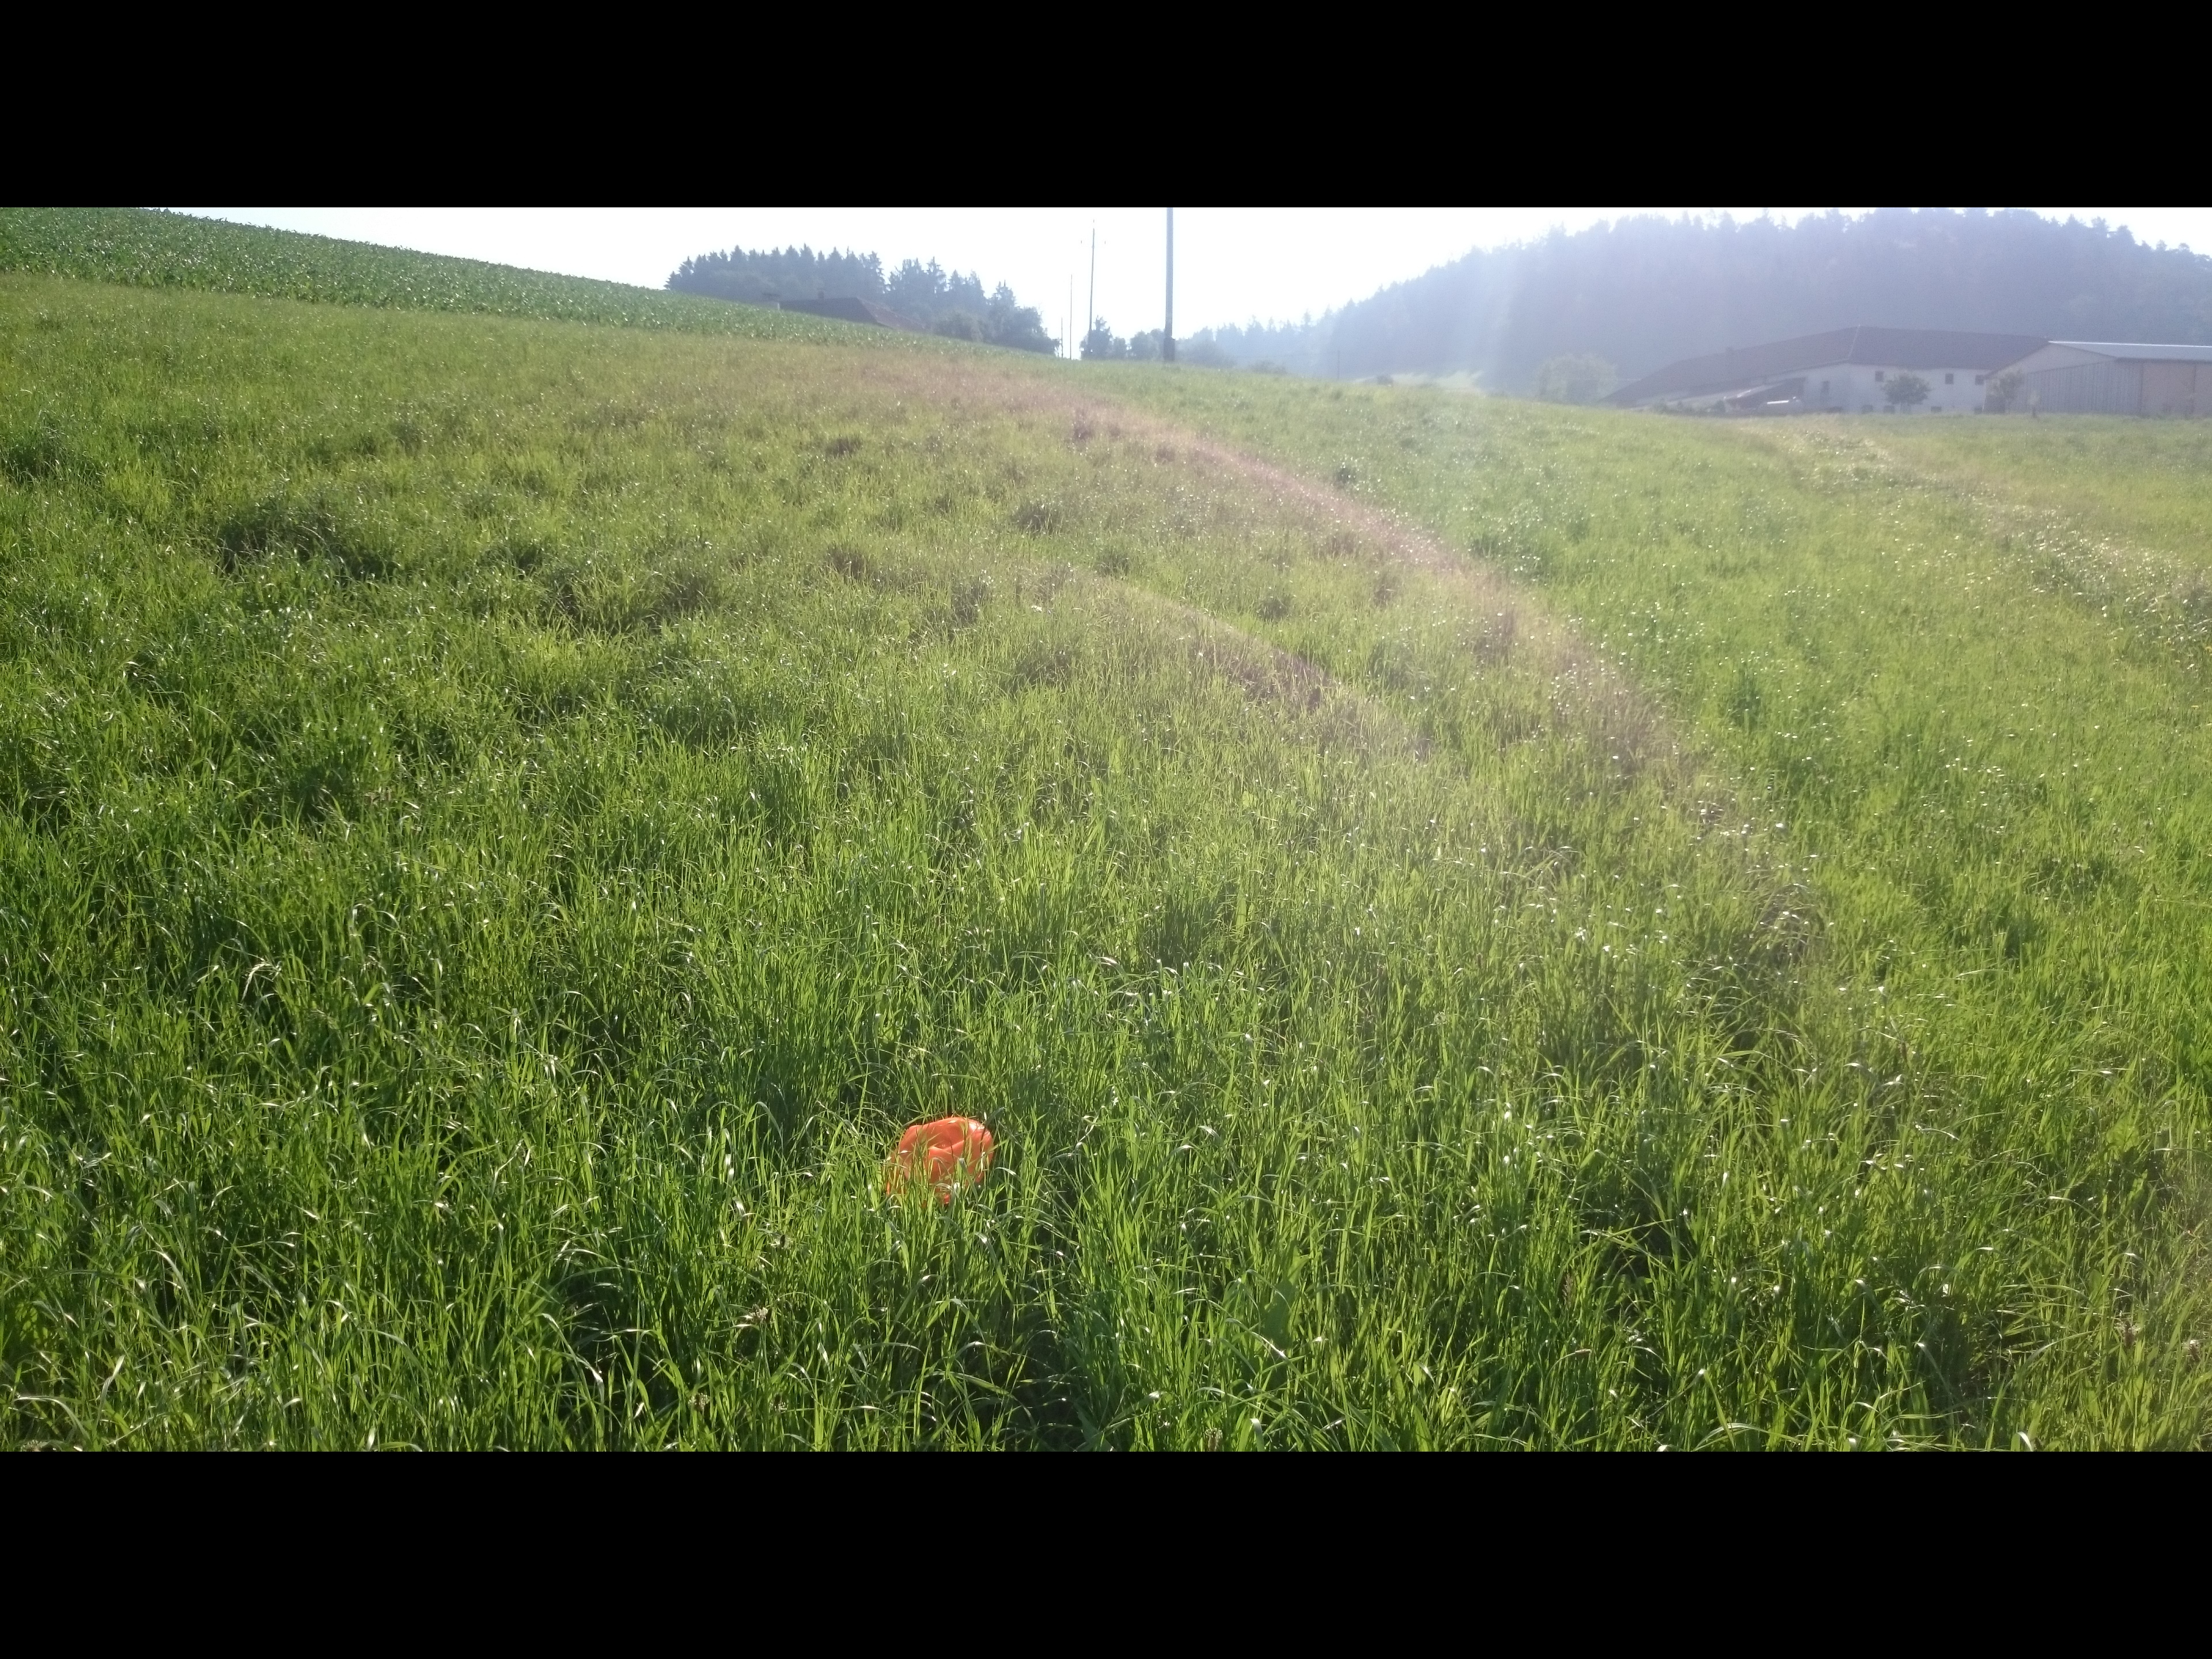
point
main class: Grassland
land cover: Grassland without tree/shrub cover
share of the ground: > 75 %
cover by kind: herbaceous plants 100 %
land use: Agriculture (excluding fallow land and kitchen gardens)
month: June
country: AT
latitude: 48.3819
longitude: 14.5509
